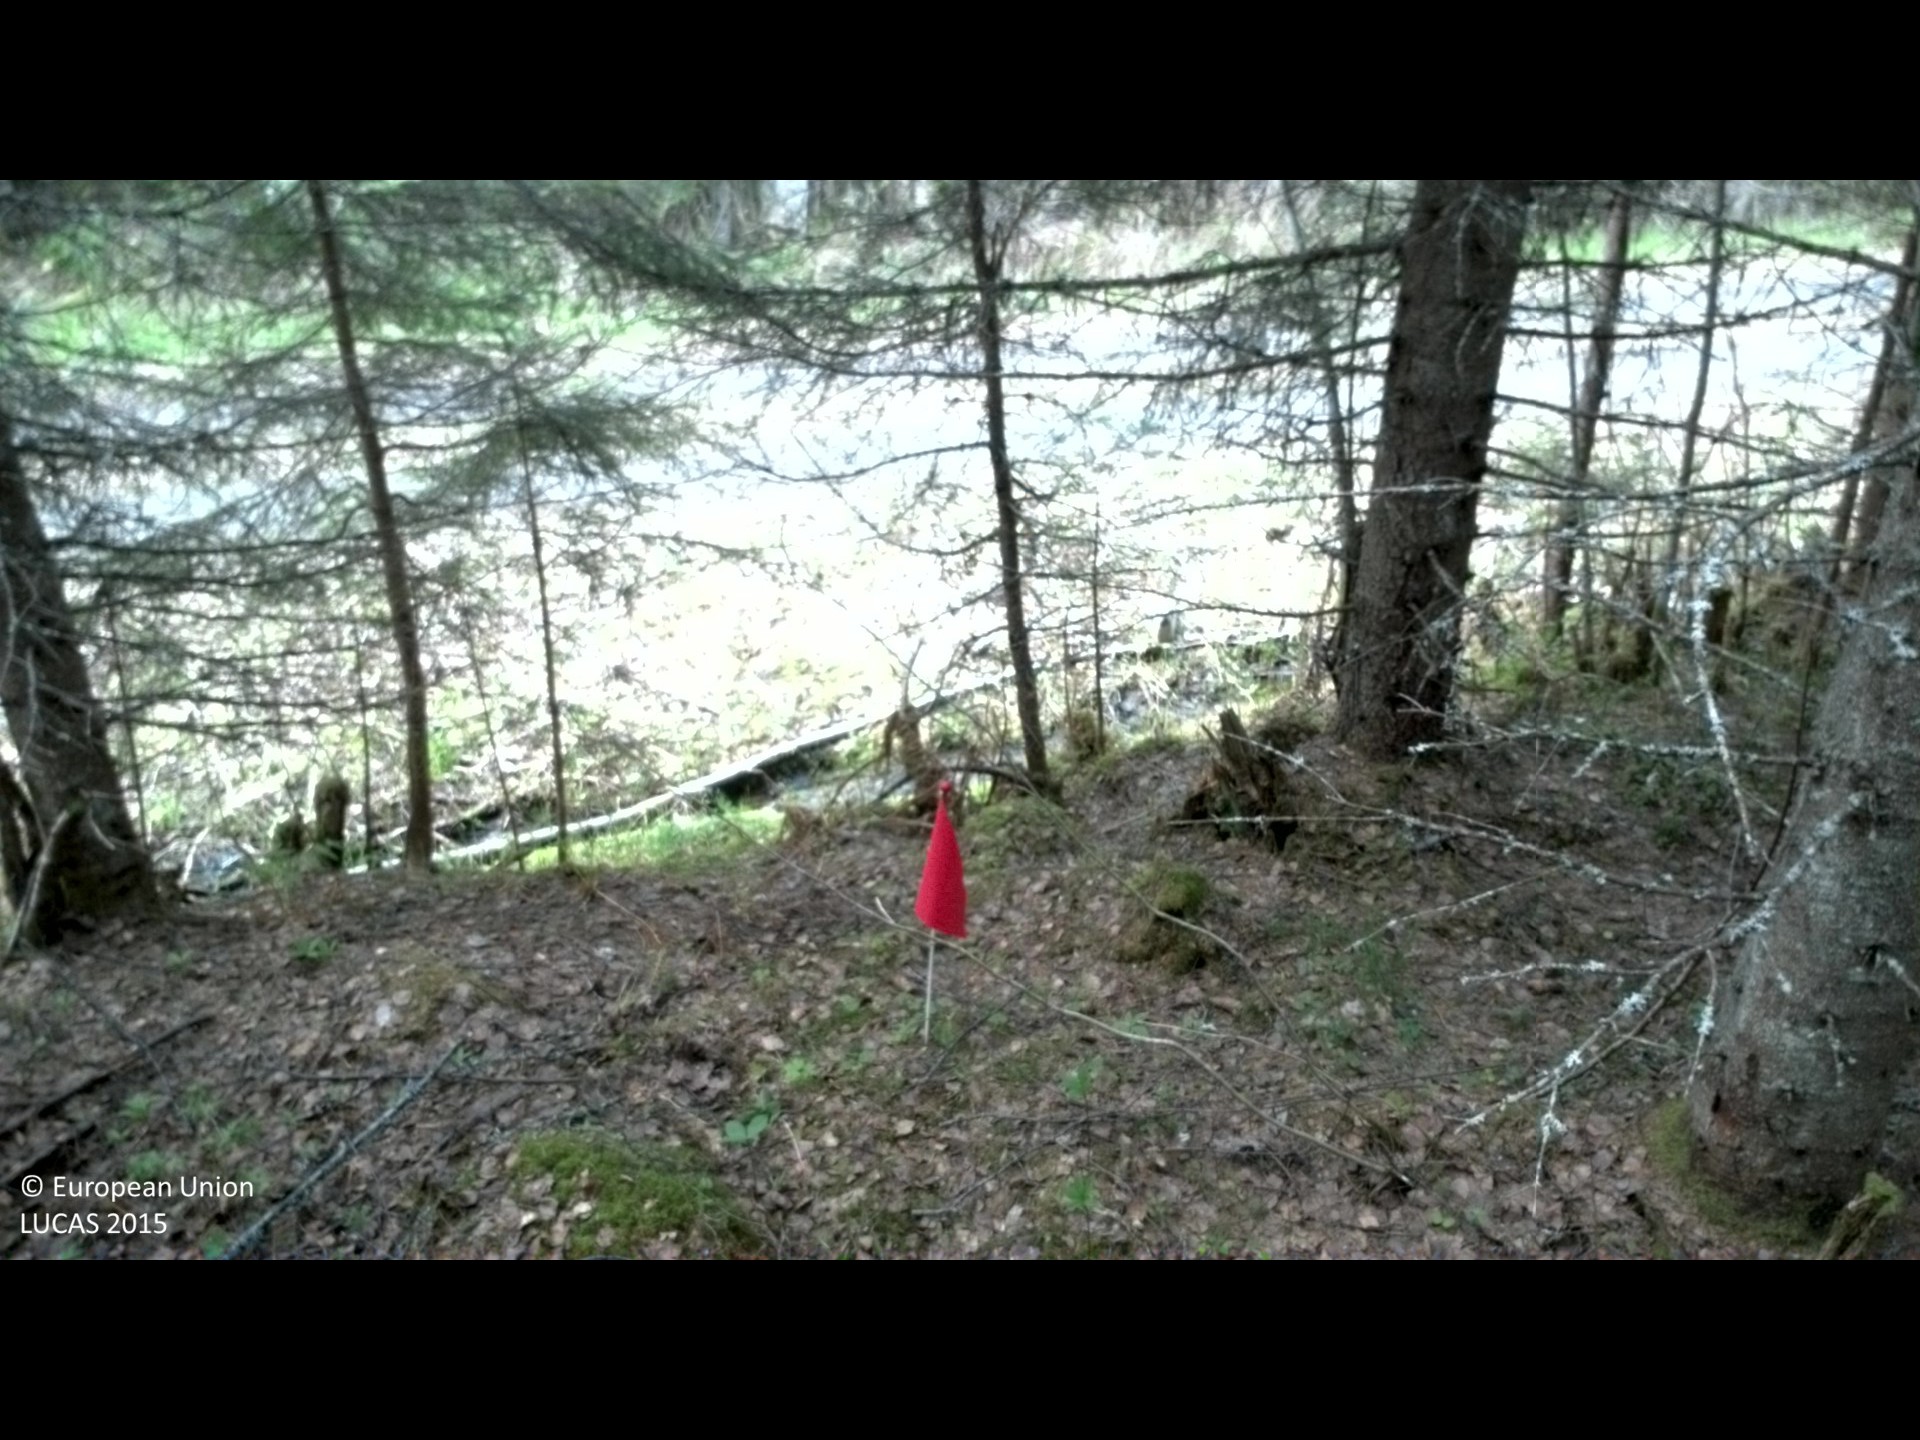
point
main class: Woodland
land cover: Spruce dominated mixed woodland
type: boreal forest
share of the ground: 50 - 75 %
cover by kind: coniferous forest trees 40 %, broadleaved forest trees 20 %
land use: Forestry
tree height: > 5 m
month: May
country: SE
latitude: 63.0328
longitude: 17.3098
